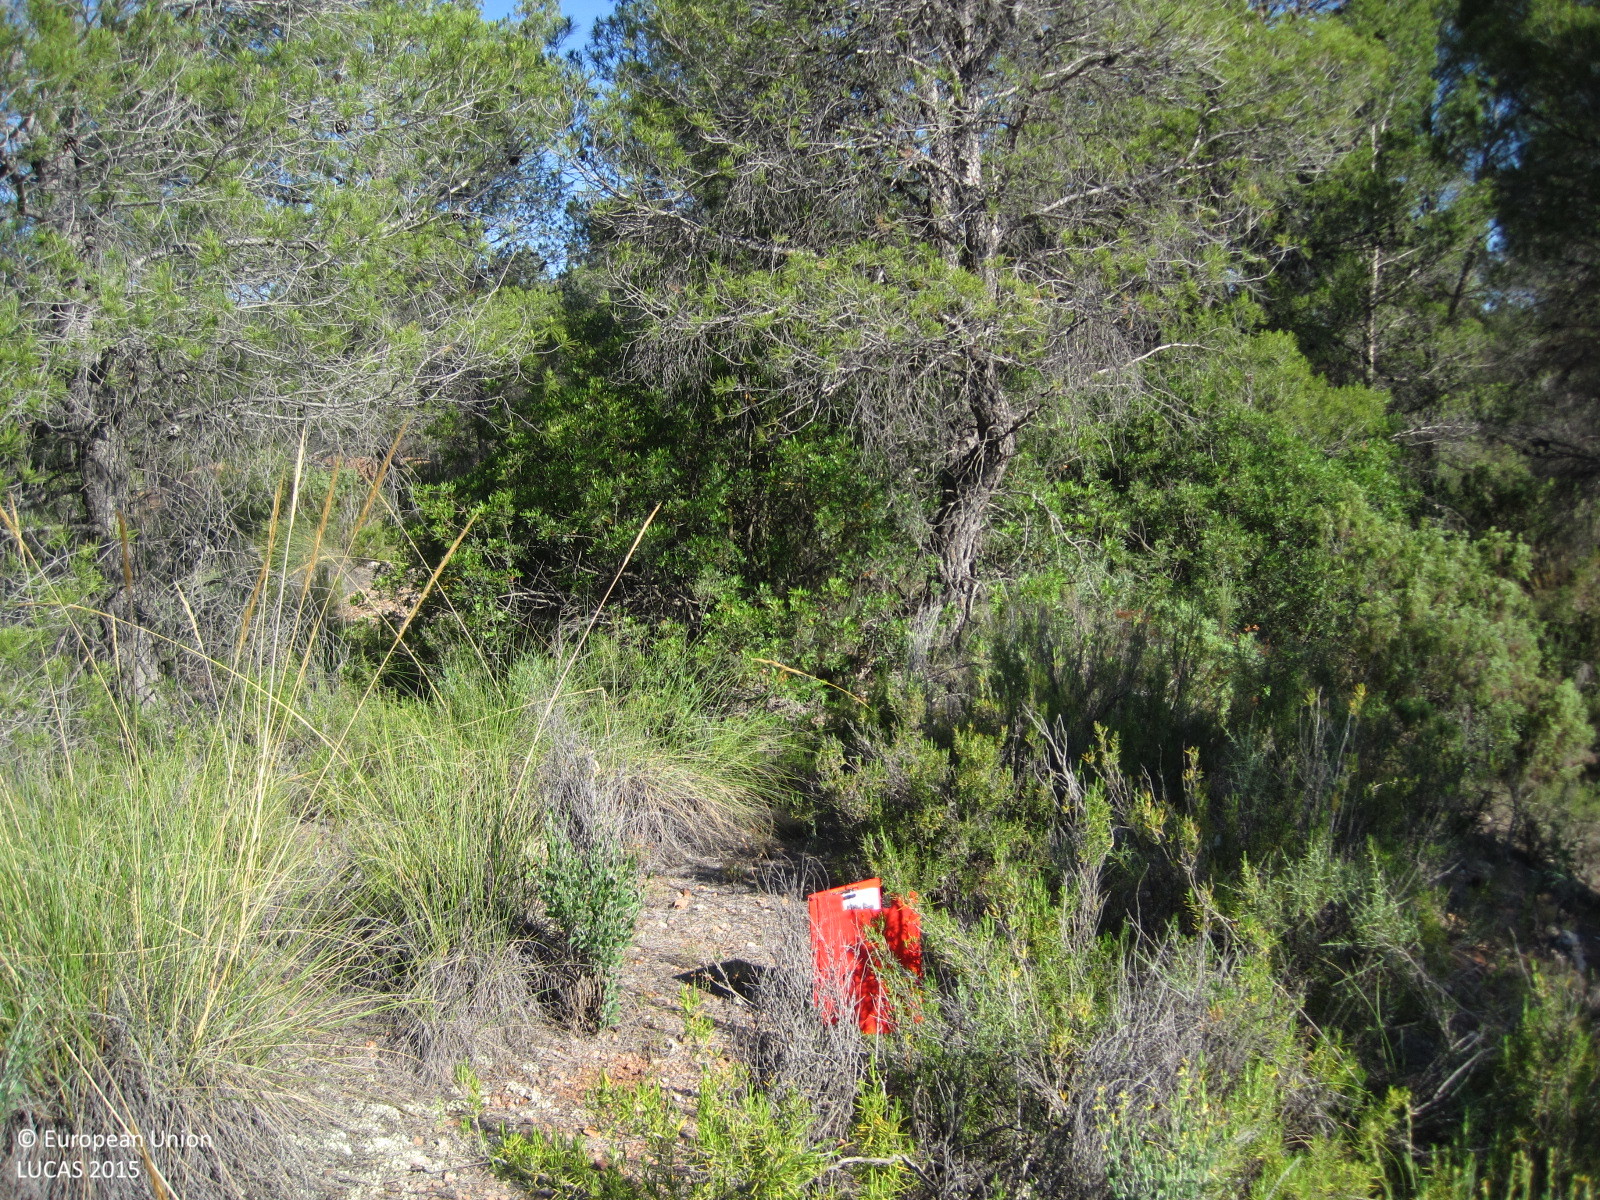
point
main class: Woodland
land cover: Pine dominated coniferous woodland
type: coniferous forest of the mediterranean region
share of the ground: 10 - 25 %
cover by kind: shrubs 40 %, coniferous forest trees 20 %, herbaceous plants 20 %, unconsolidated bare surface 20 %
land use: Semi-natural and natural areas not in use
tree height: > 5 m
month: June
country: ES
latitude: 39.2561
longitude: -1.0655
